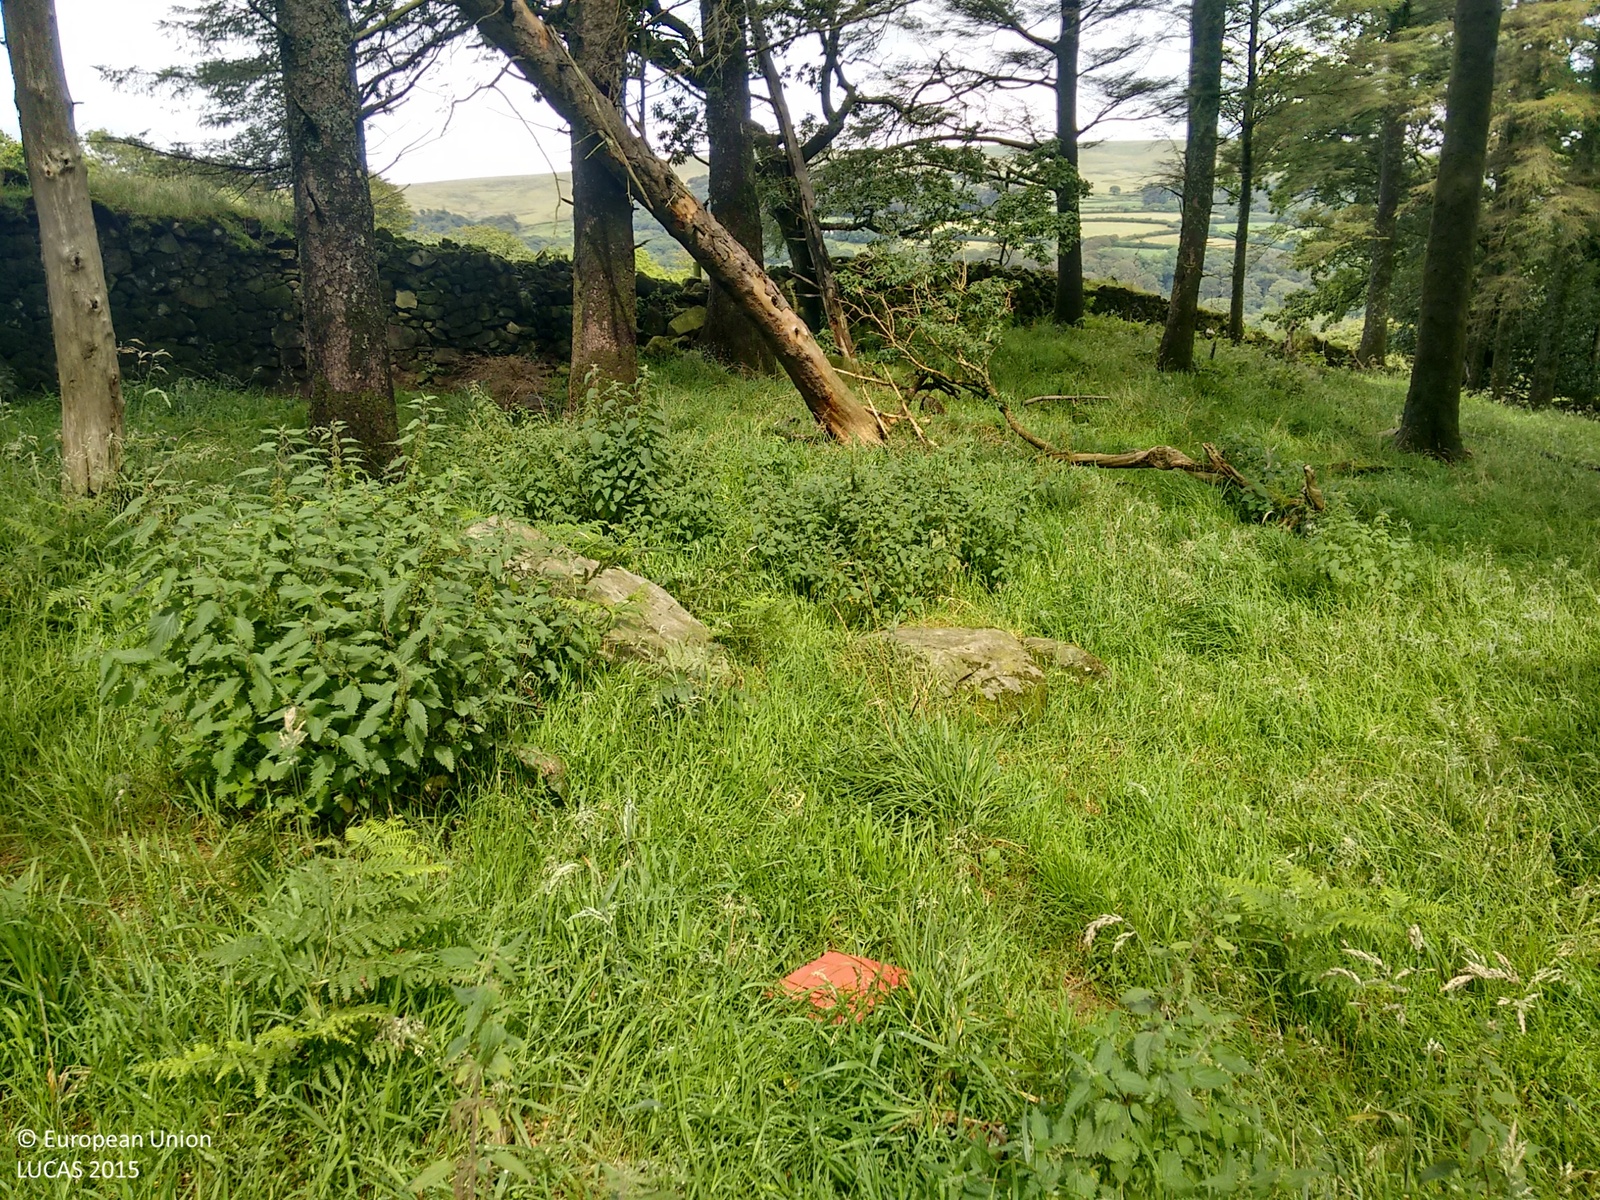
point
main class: Woodland
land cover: Spruce dominated coniferous woodland
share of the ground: > 75 %
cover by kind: coniferous forest trees 100 %
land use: Semi-natural and natural areas not in use
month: August
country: GB
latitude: 50.4335
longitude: -3.9601
